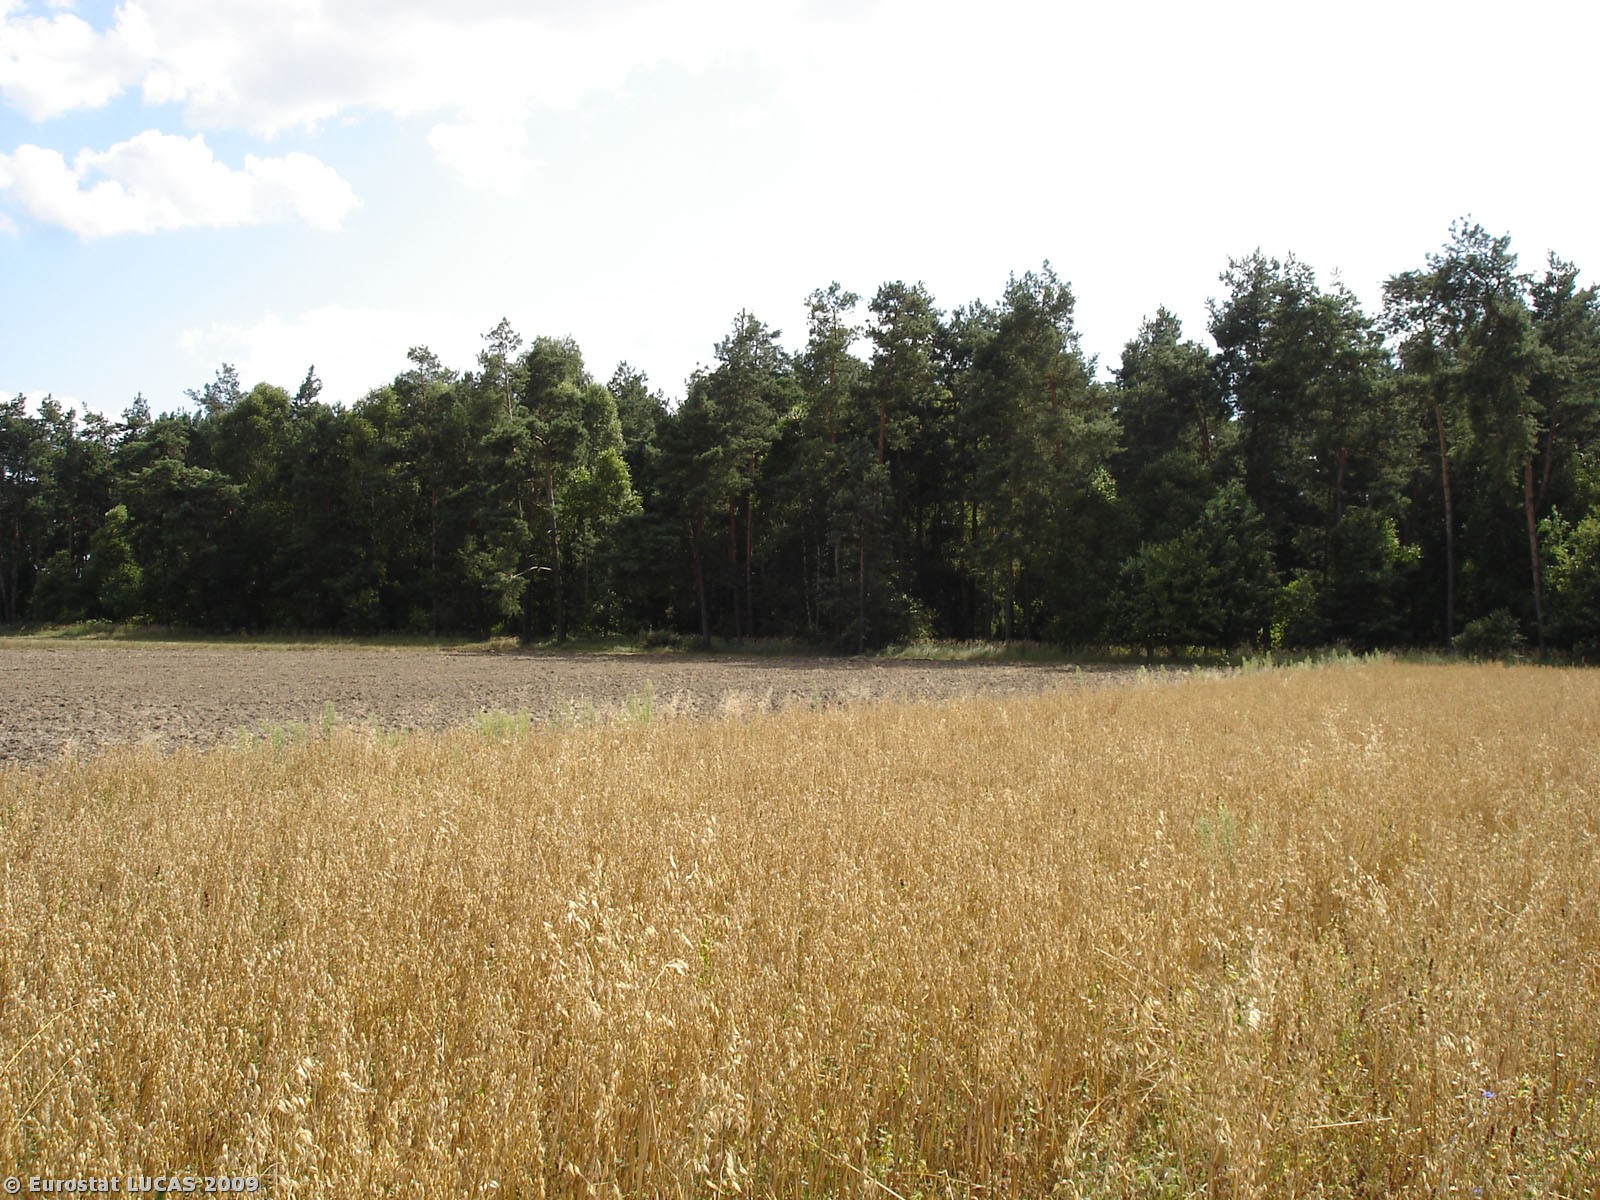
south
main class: Cropland
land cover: Oats
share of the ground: > 75 %
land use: Agriculture (excluding fallow land and kitchen gardens)
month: August
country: PL
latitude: 50.9779
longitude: 18.8671
